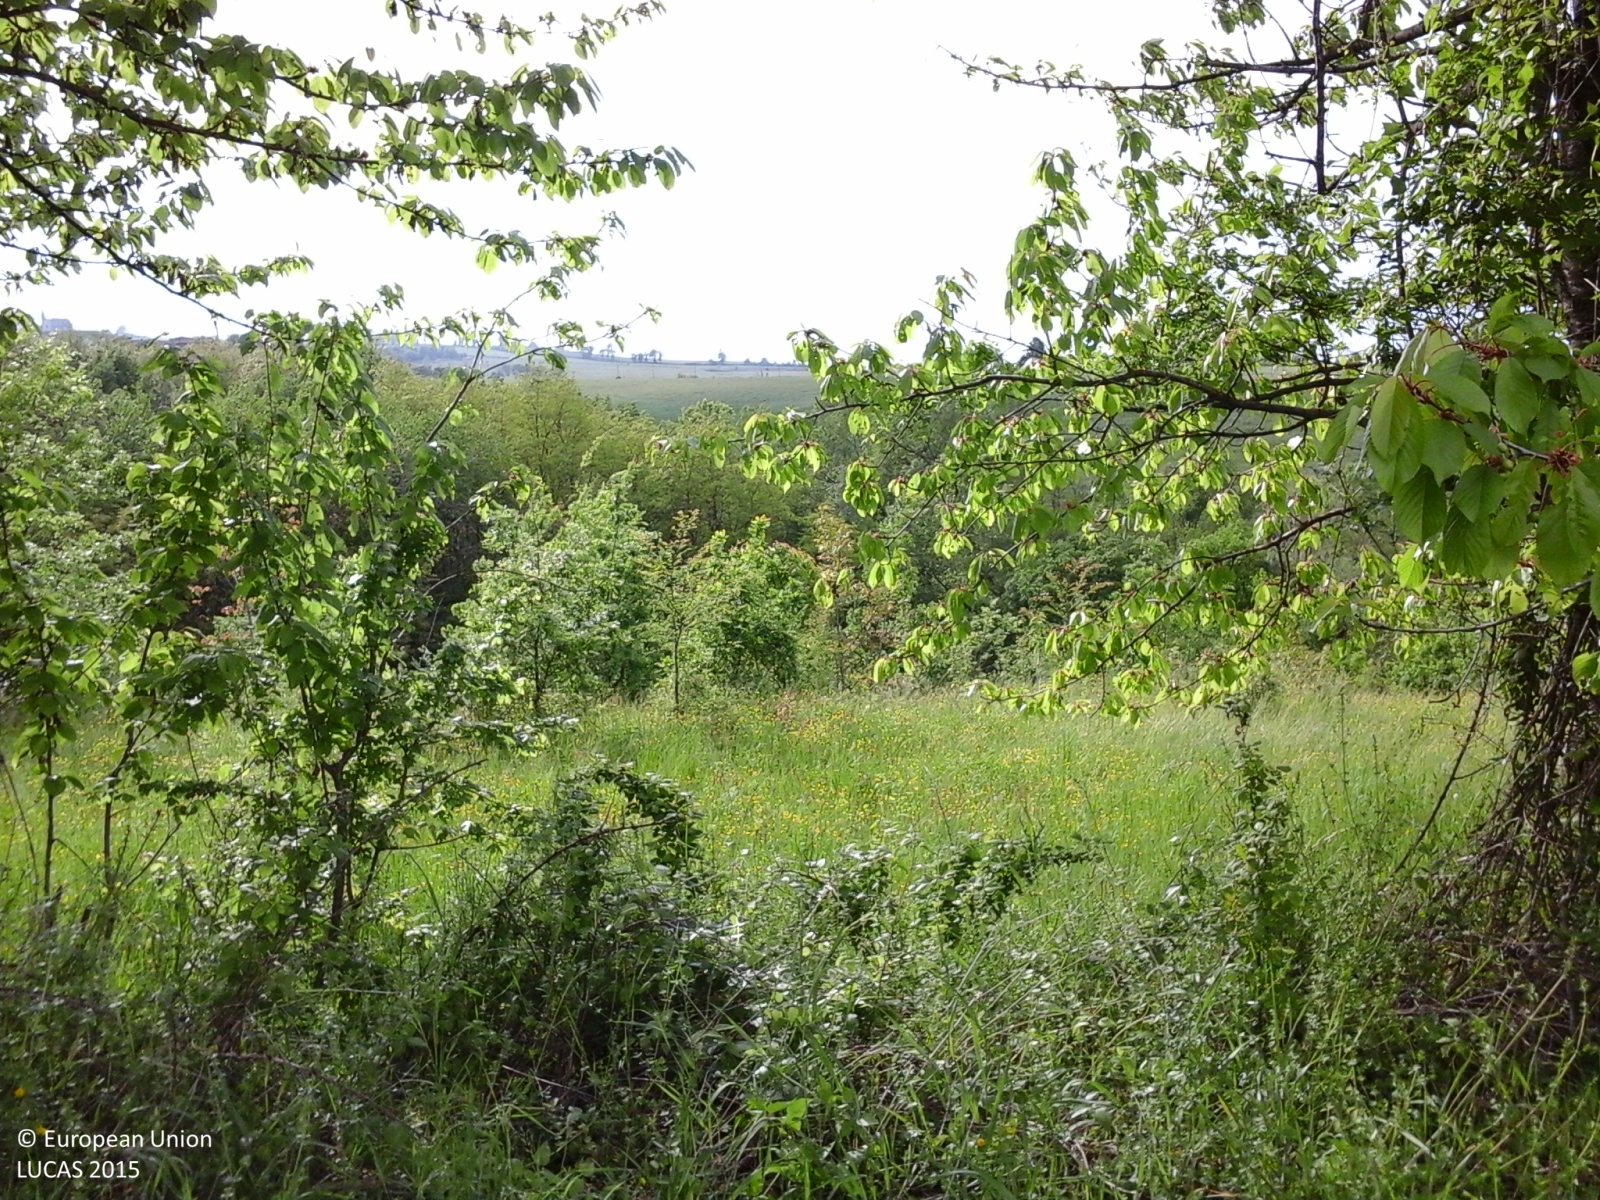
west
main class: Woodland
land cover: Broadleaved woodland
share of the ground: > 75 %
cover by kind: broadleaved forest trees 80 %, shrubs 15 %, herbaceous plants 5 %
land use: Semi-natural and natural areas not in use
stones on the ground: < 10 %
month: May
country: IT
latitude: 44.9267
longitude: 9.5574
